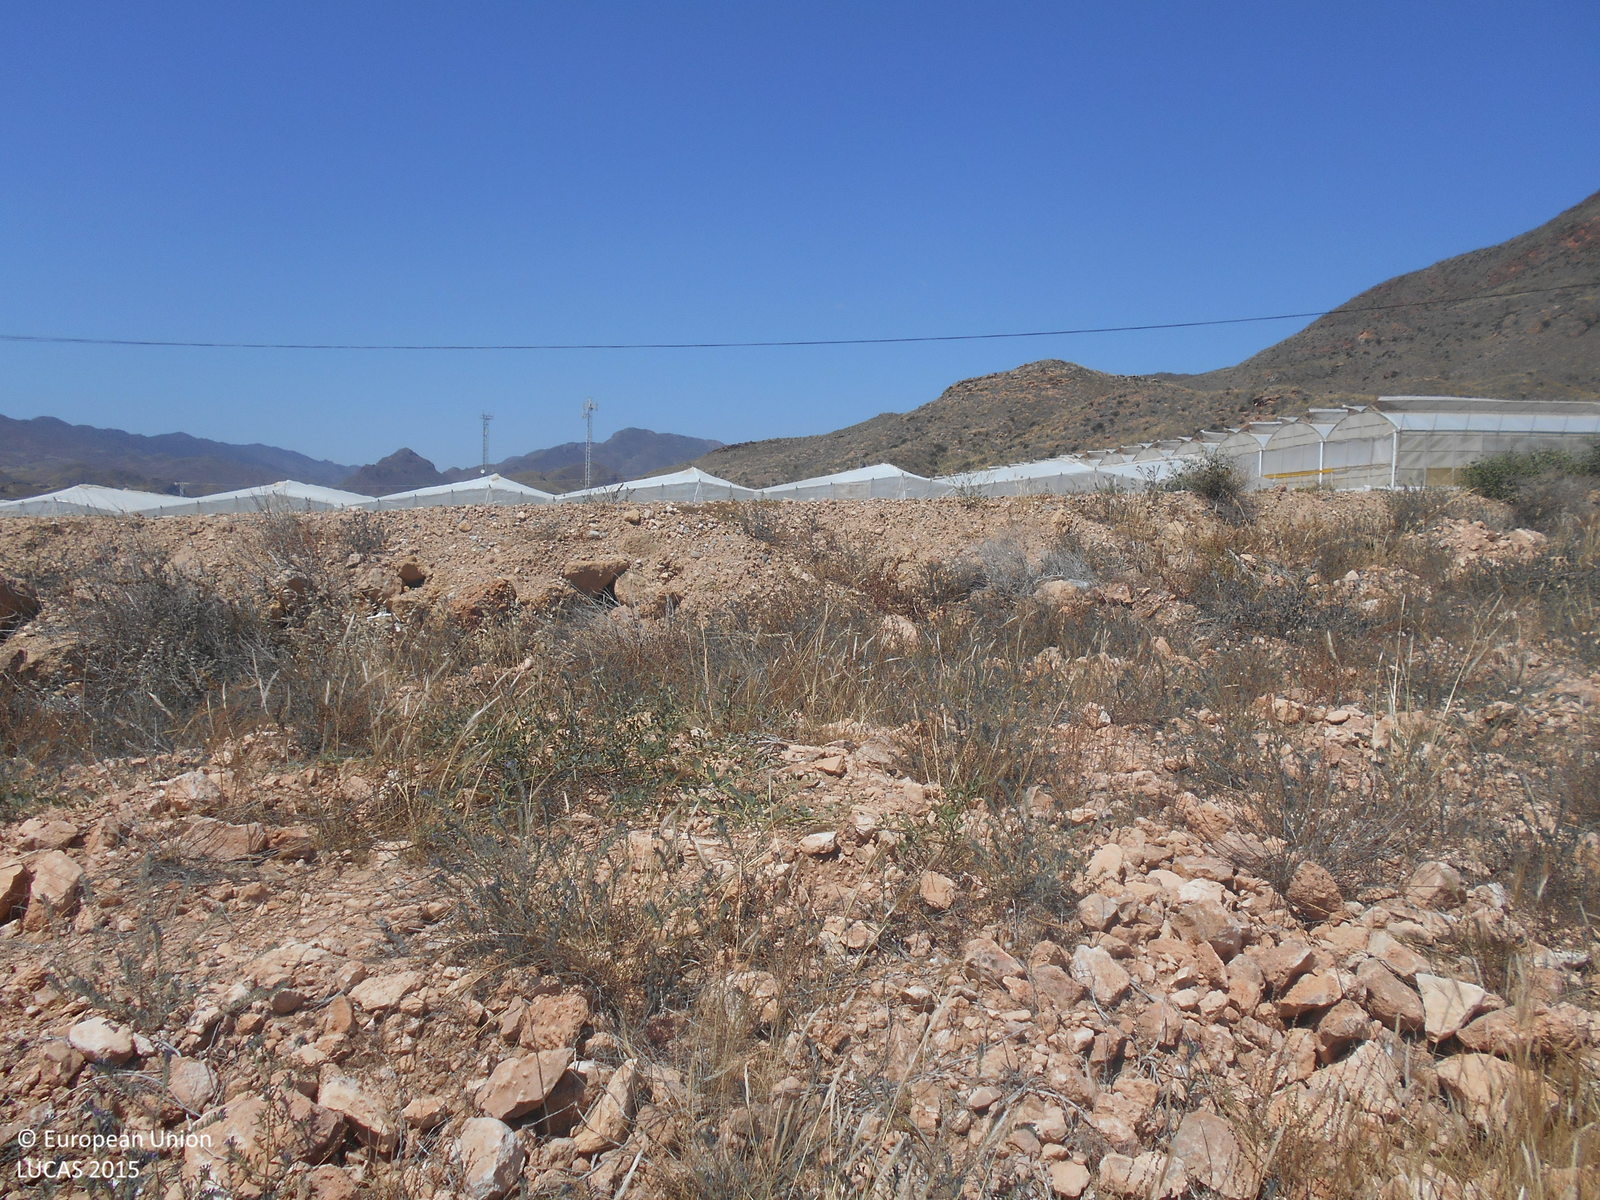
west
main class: Shrubland
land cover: Shrubland without tree cover
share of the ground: 50 - 75 %
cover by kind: herbaceous plants 40 %, shrubs 20 %, consolidated bare surface 20 %, unconsolidated bare surface 20 %
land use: Semi-natural and natural areas not in use
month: May
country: ES
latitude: 37.5481
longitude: -1.4456
